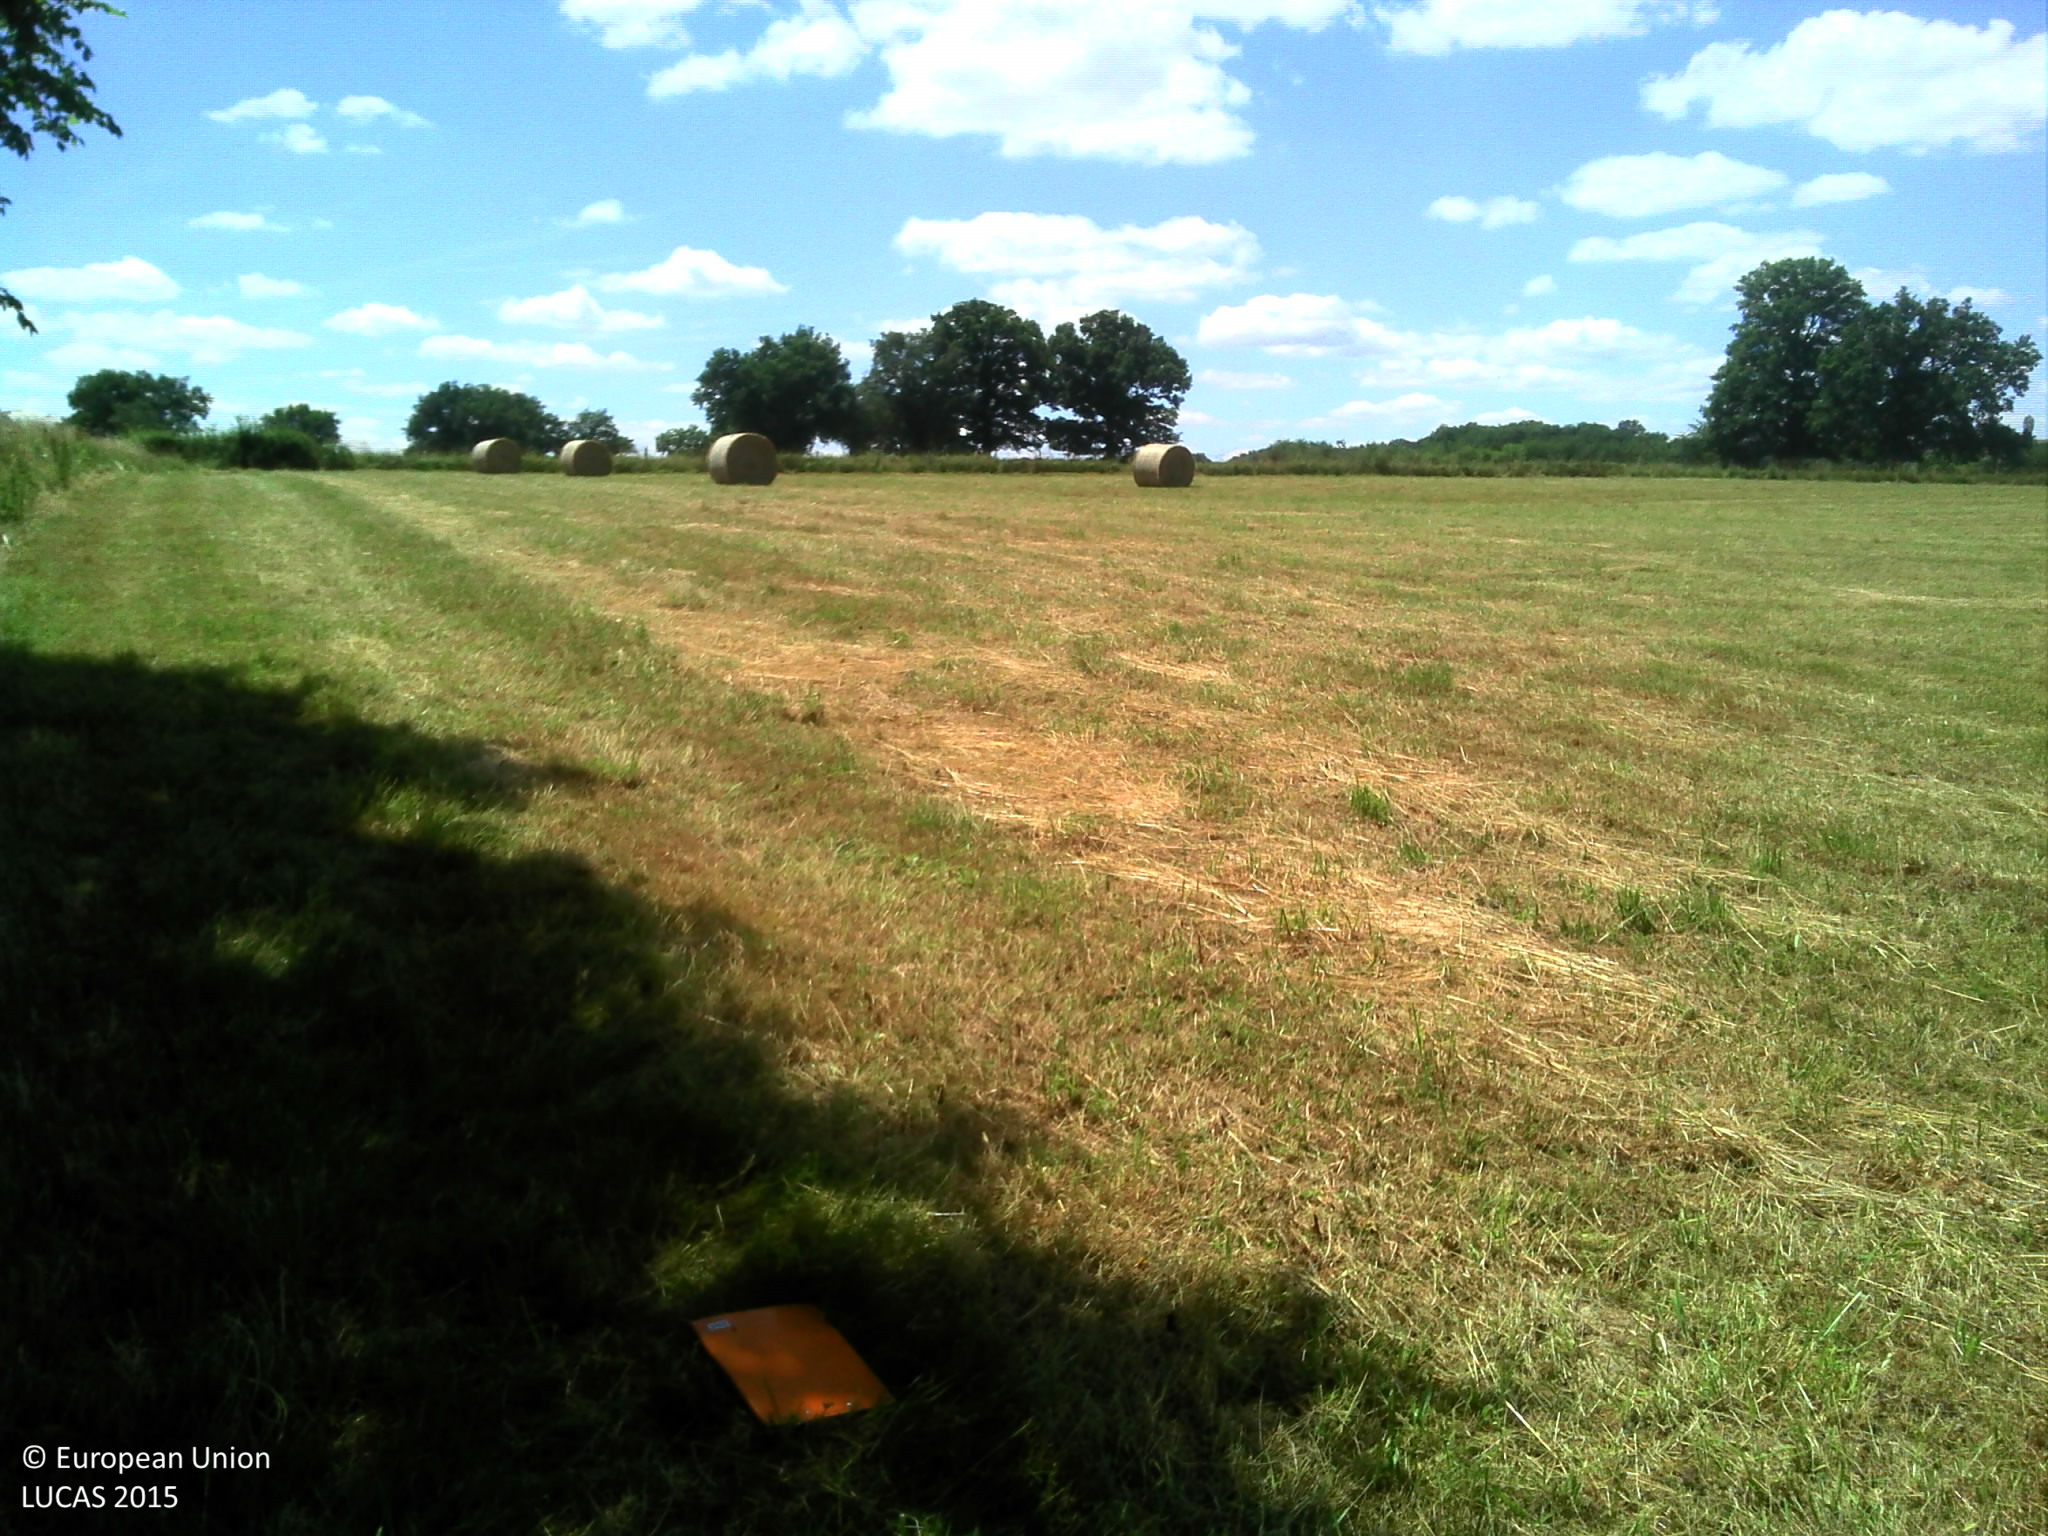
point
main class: Grassland
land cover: Grassland without tree/shrub cover
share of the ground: > 75 %
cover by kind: herbaceous plants 100 %
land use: Agriculture (excluding fallow land and kitchen gardens)
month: June
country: FR
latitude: 46.2023
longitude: 4.0266
